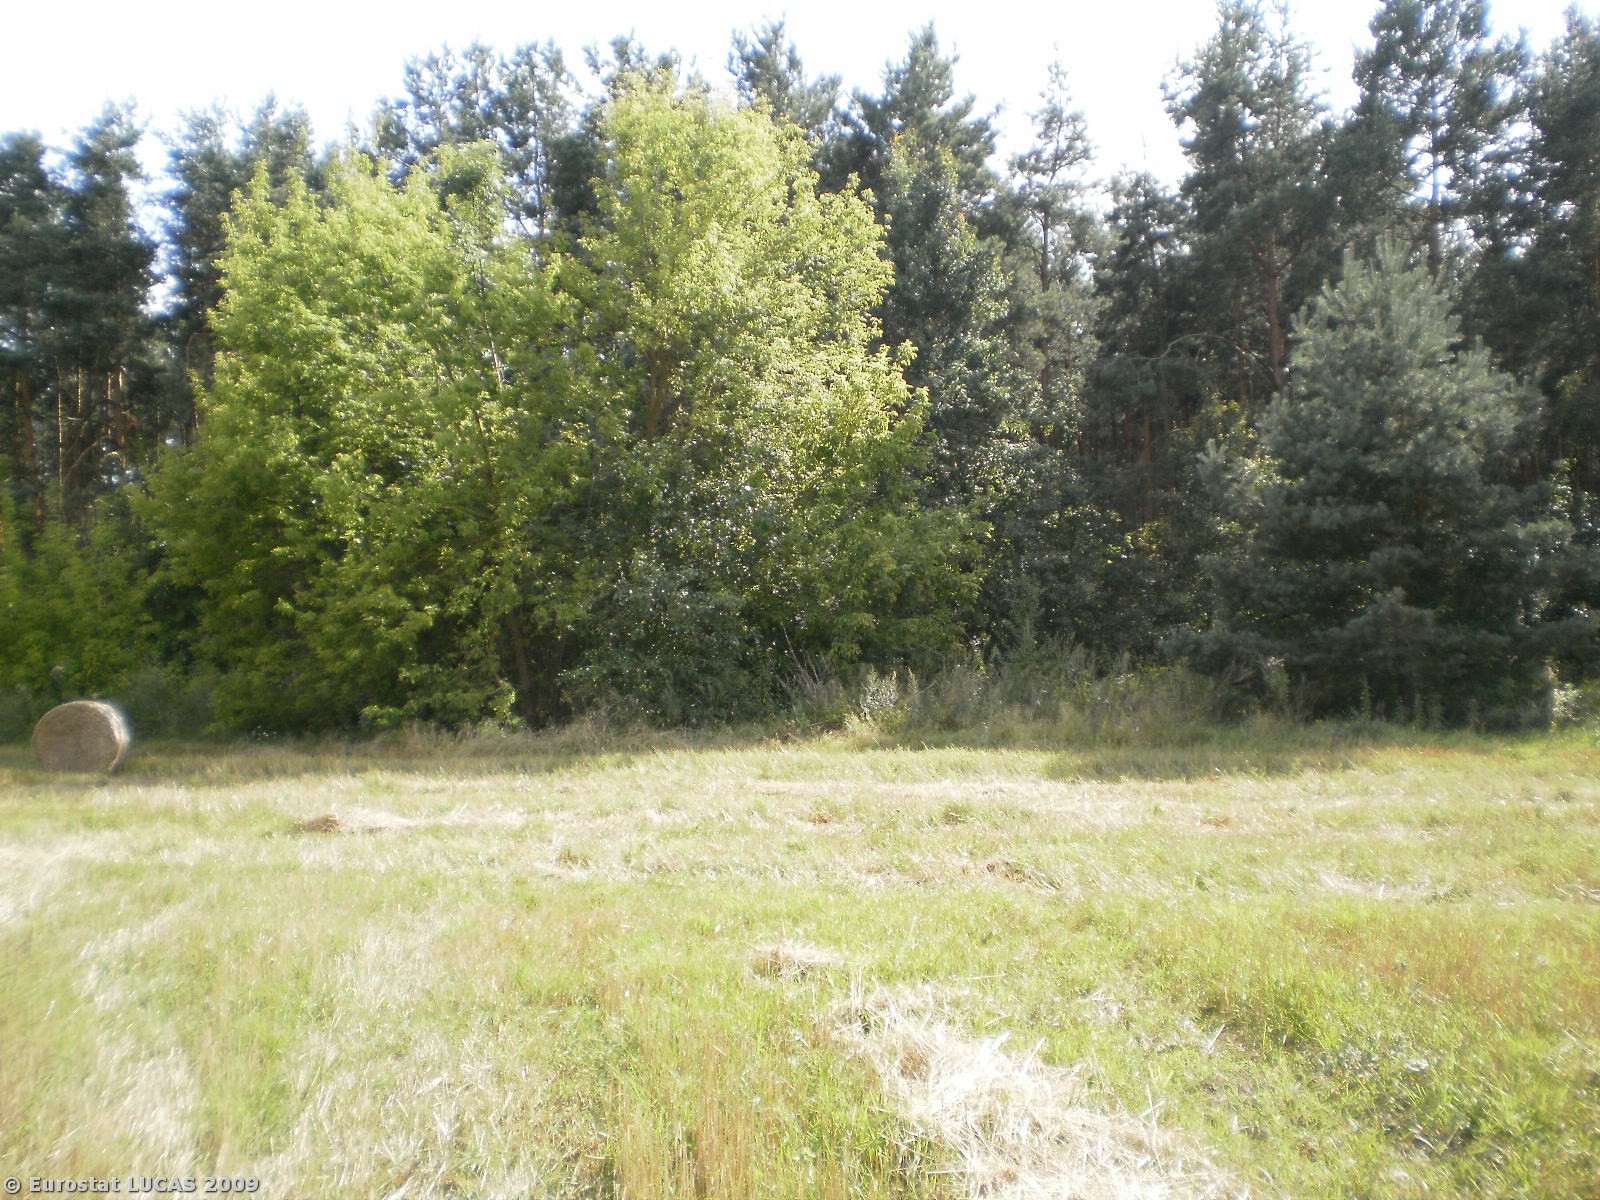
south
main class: Cropland
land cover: Rye
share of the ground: < 10 %
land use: Agriculture (excluding fallow land and kitchen gardens)
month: August
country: PL
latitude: 52.8528
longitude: 21.8618
